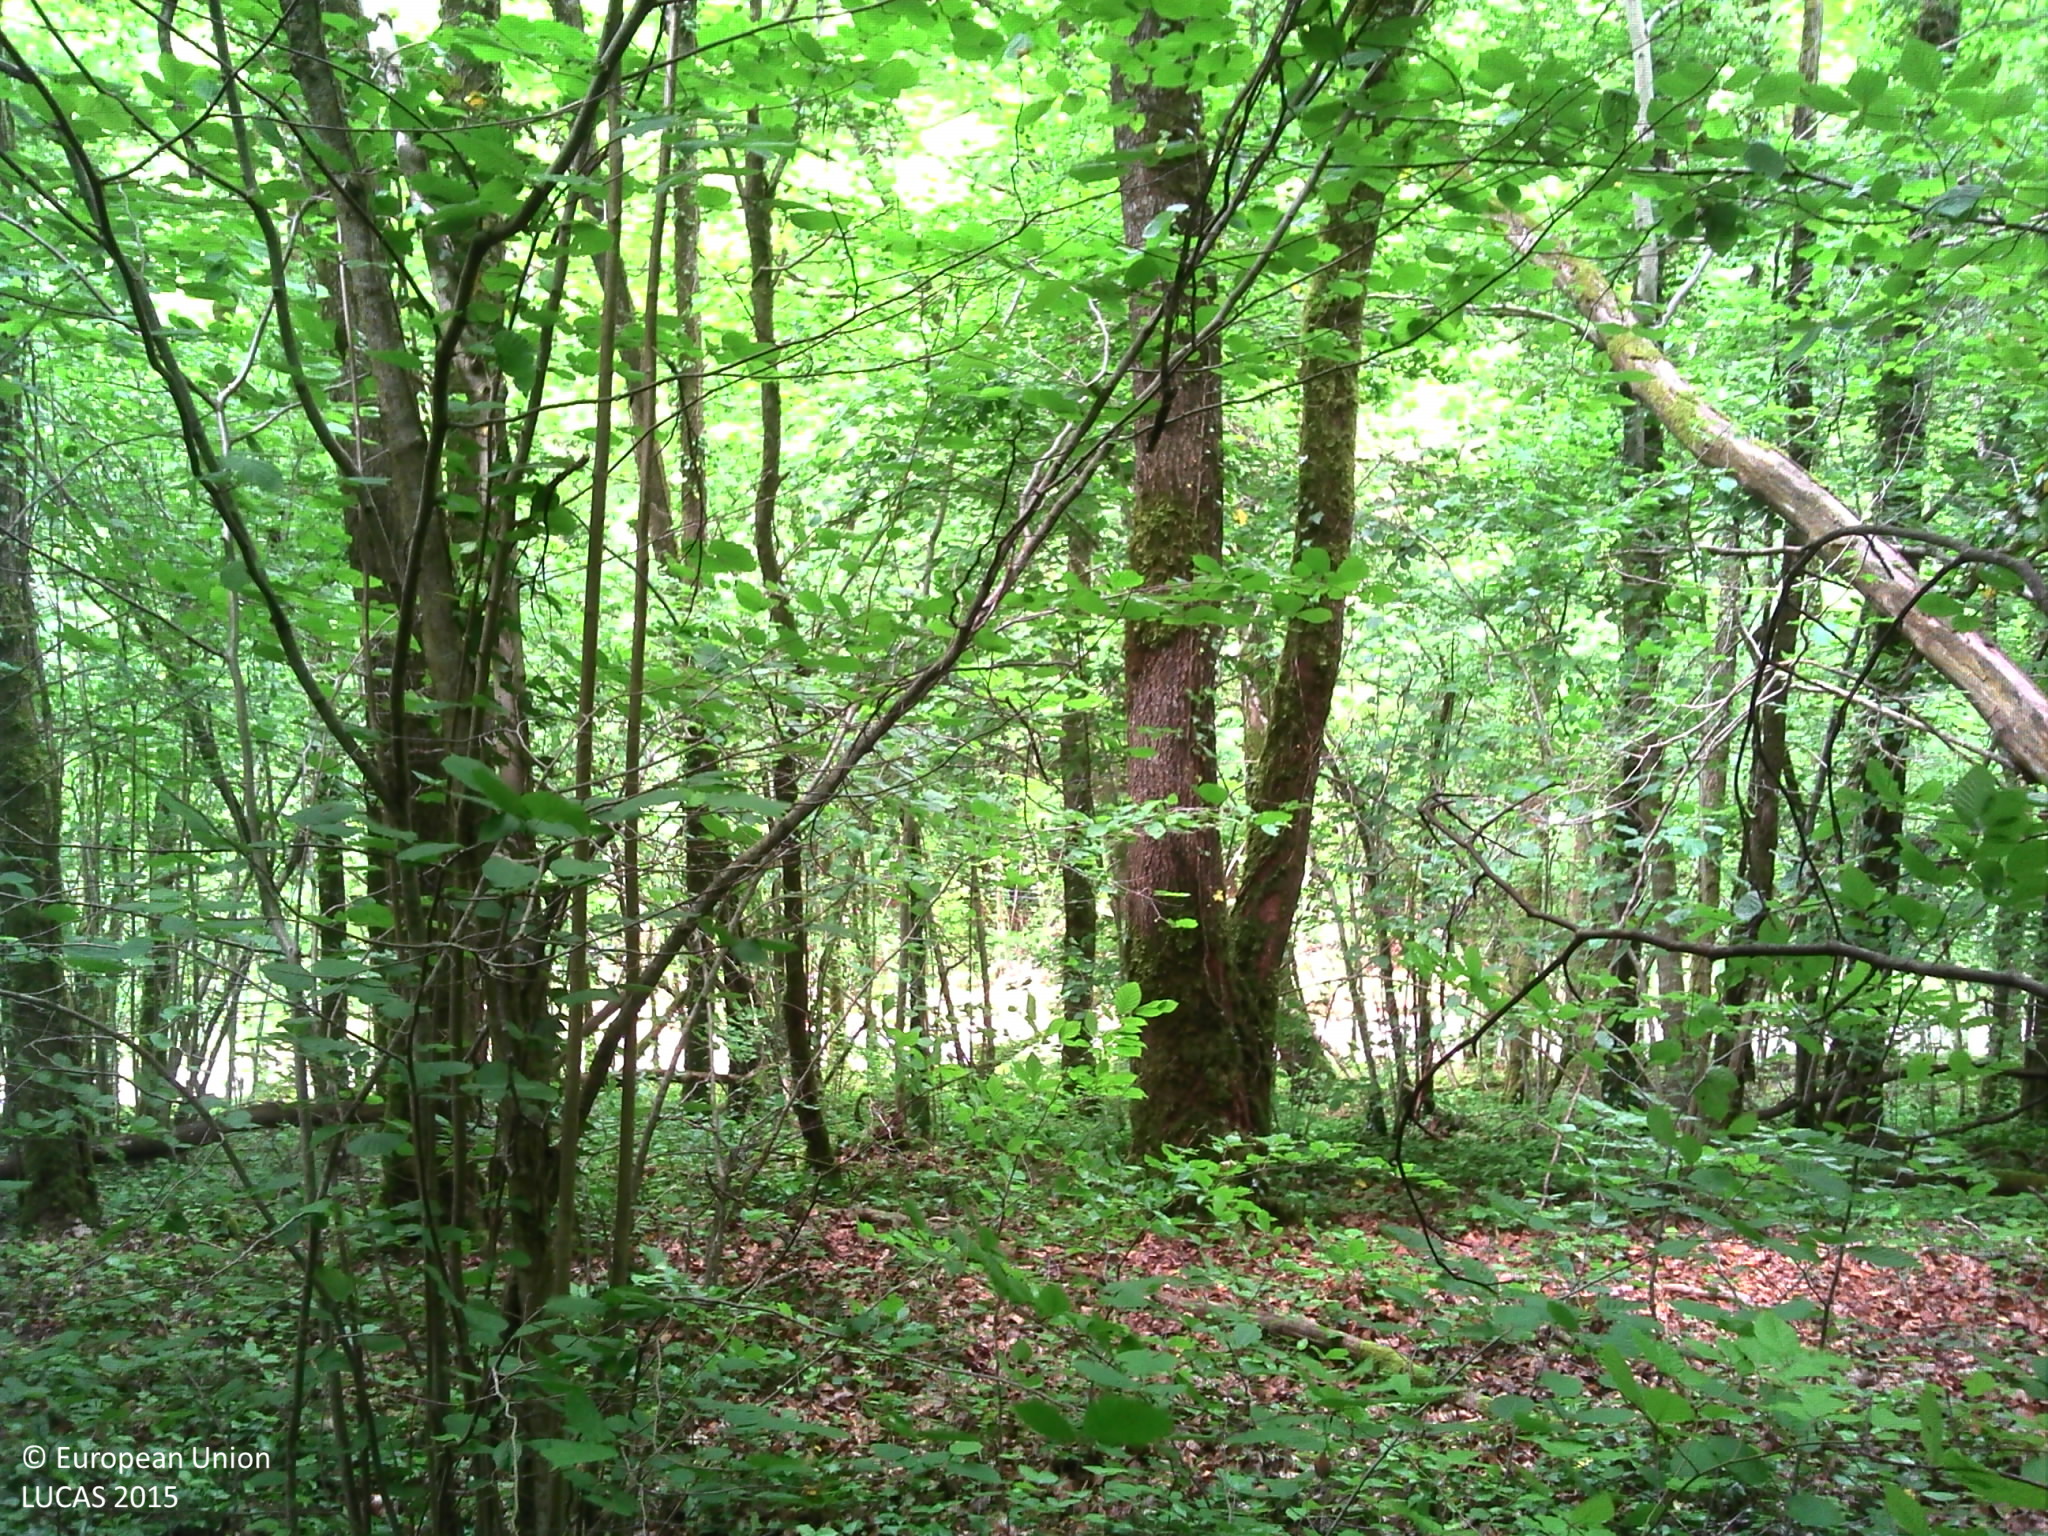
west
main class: Woodland
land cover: Broadleaved woodland
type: acidophilous oak and oak-birch forest
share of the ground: > 75 %
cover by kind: broadleaved forest trees 90 %, herbaceous plants 10 %
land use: Forestry
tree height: > 5 m
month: June
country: FR
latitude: 48.5320
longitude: 5.1641
